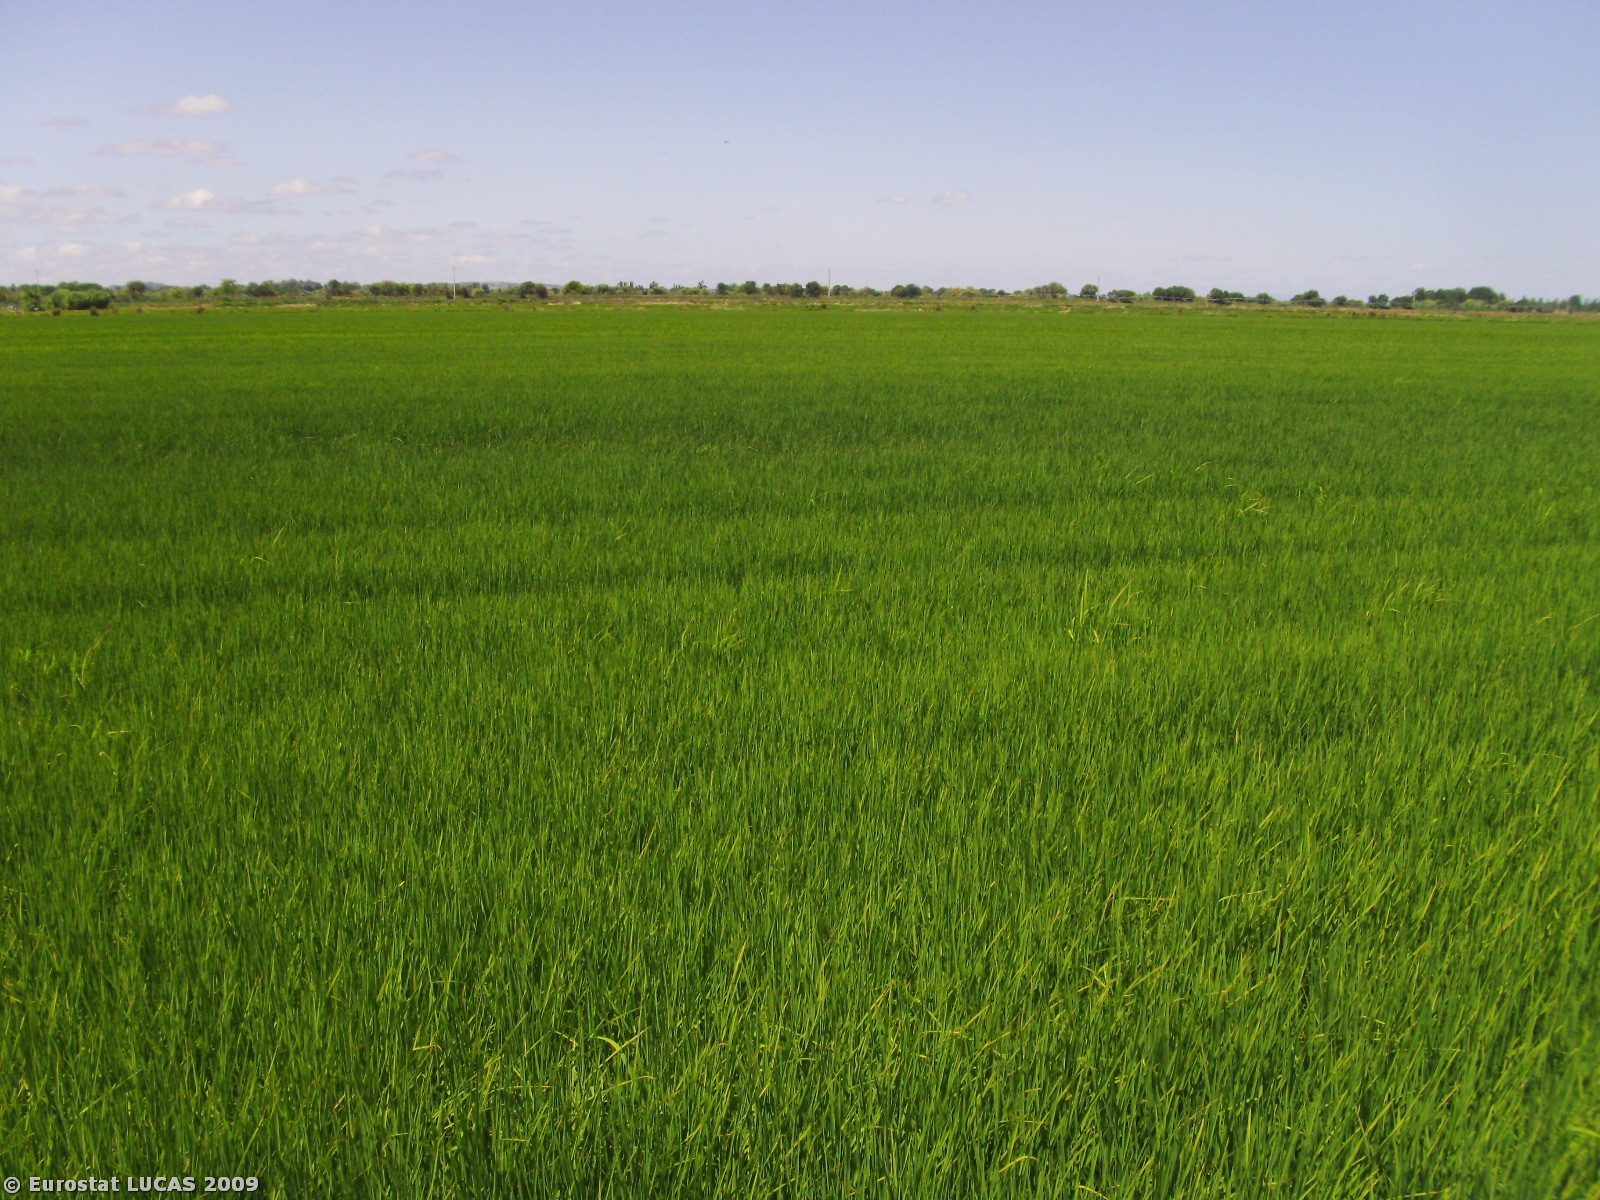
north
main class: Cropland
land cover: Rice
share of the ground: > 75 %
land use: Agriculture (excluding fallow land and kitchen gardens)
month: July
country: PT
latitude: 39.0204
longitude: -8.8177
